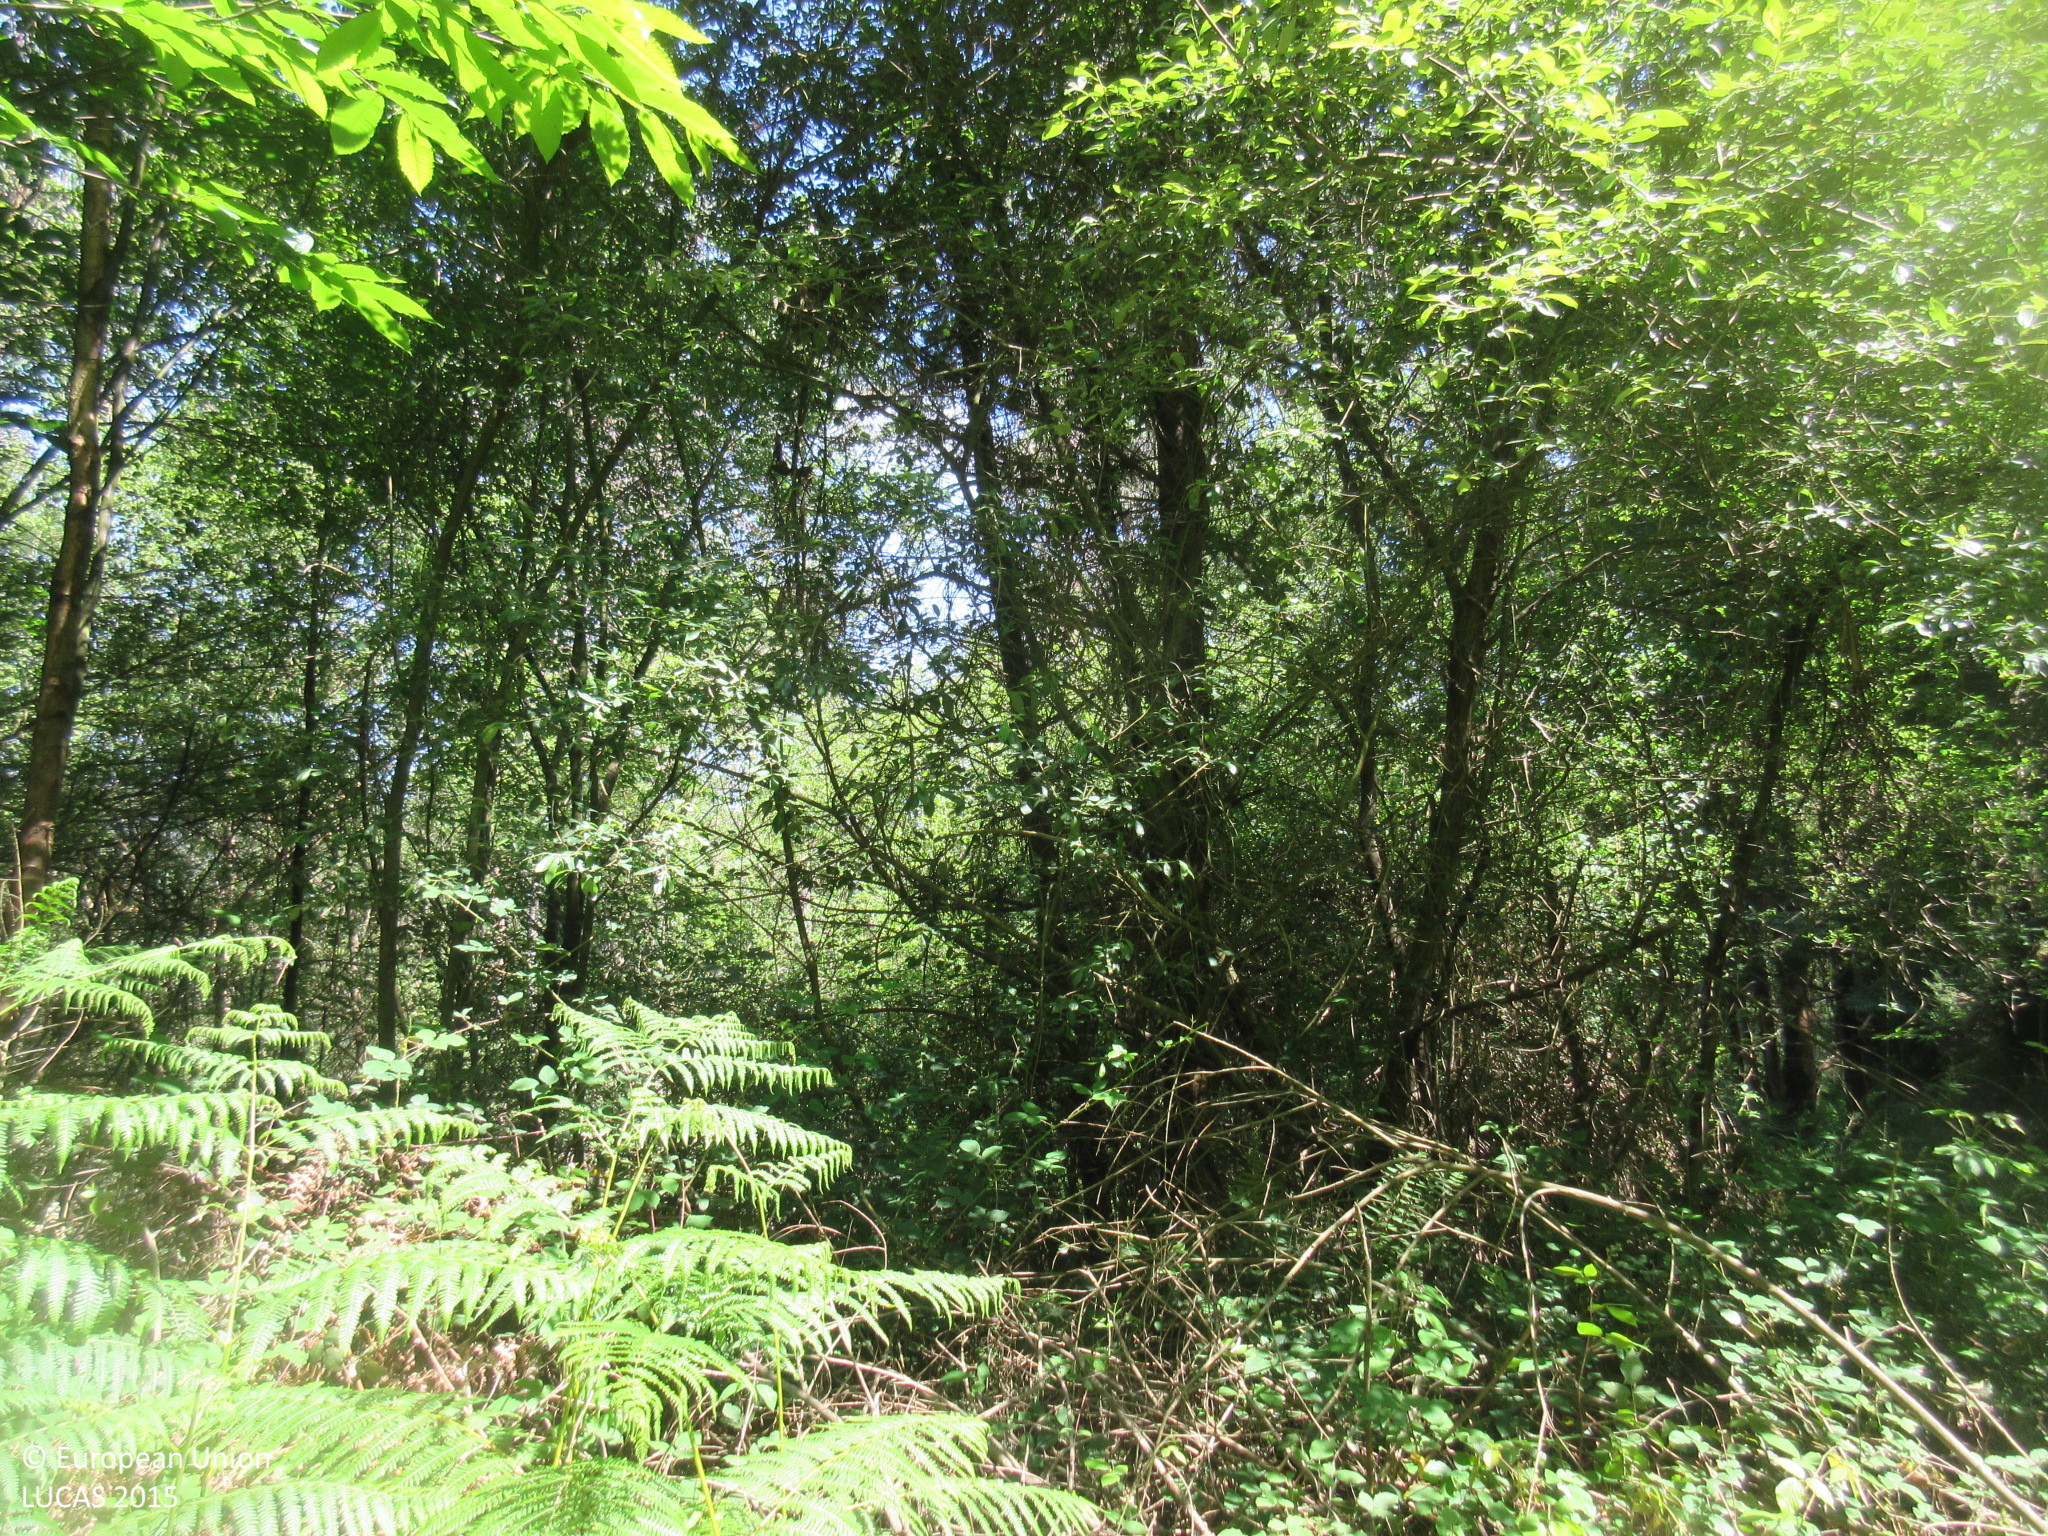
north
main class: Woodland
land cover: Broadleaved woodland
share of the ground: > 75 %
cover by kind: broadleaved forest trees 90 %, shrubs 10 %
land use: Forestry
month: June
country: ES
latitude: 43.4665
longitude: -6.0005
